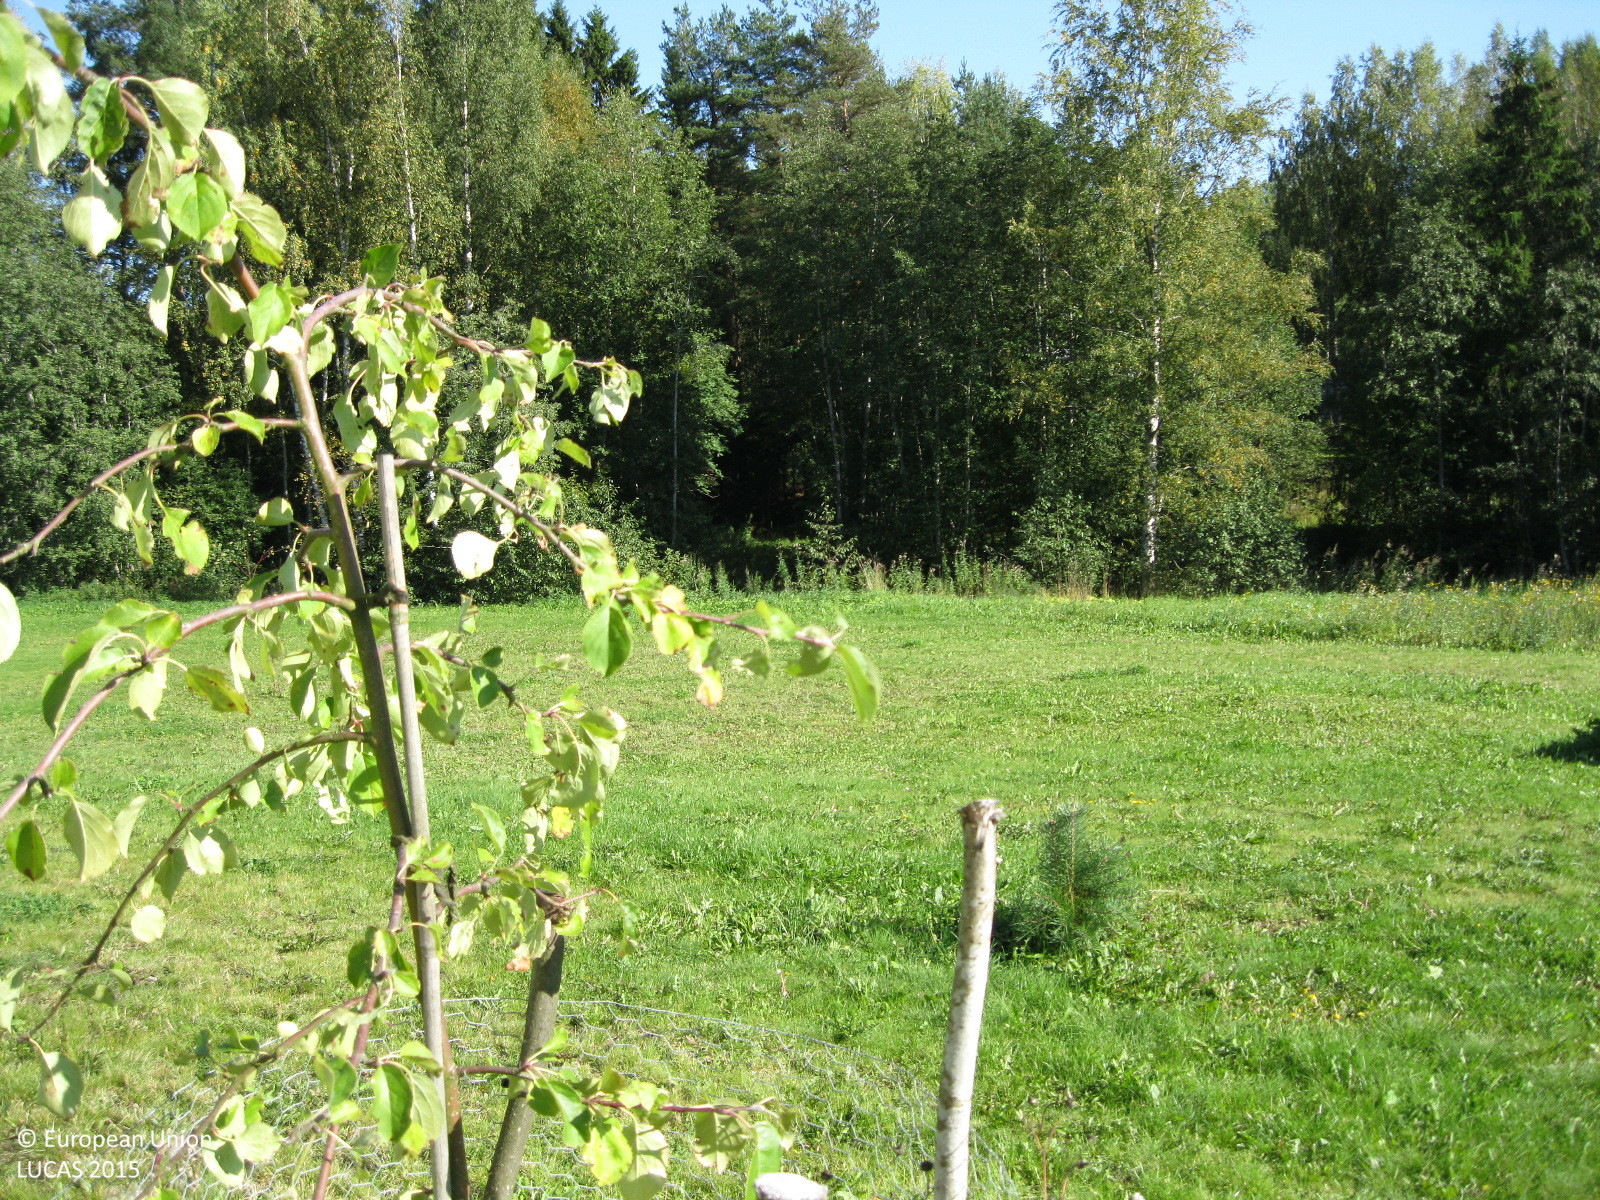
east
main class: Grassland
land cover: Grassland with sparse tree/shrub cover
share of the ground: > 75 %
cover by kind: herbaceous plants 95 %, coniferous forest trees 5 %
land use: Residential
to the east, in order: Grassland with sparse tree/shrub cover; Spontaneously vegetated surfaces; Rivers and streams; Spruce dominated mixed woodland; Tracks; Spruce dominated mixed woodland; Spontaneously vegetated surfaces; Ditches and canals; Oats; Grass margins; Ditches and canals; Grass margins; Paved roads, cycling and walking lanes; Grass margins; Ditches and canals; Grassland without tree/shrub cover
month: September
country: FI
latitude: 60.6595
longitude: 24.9901
